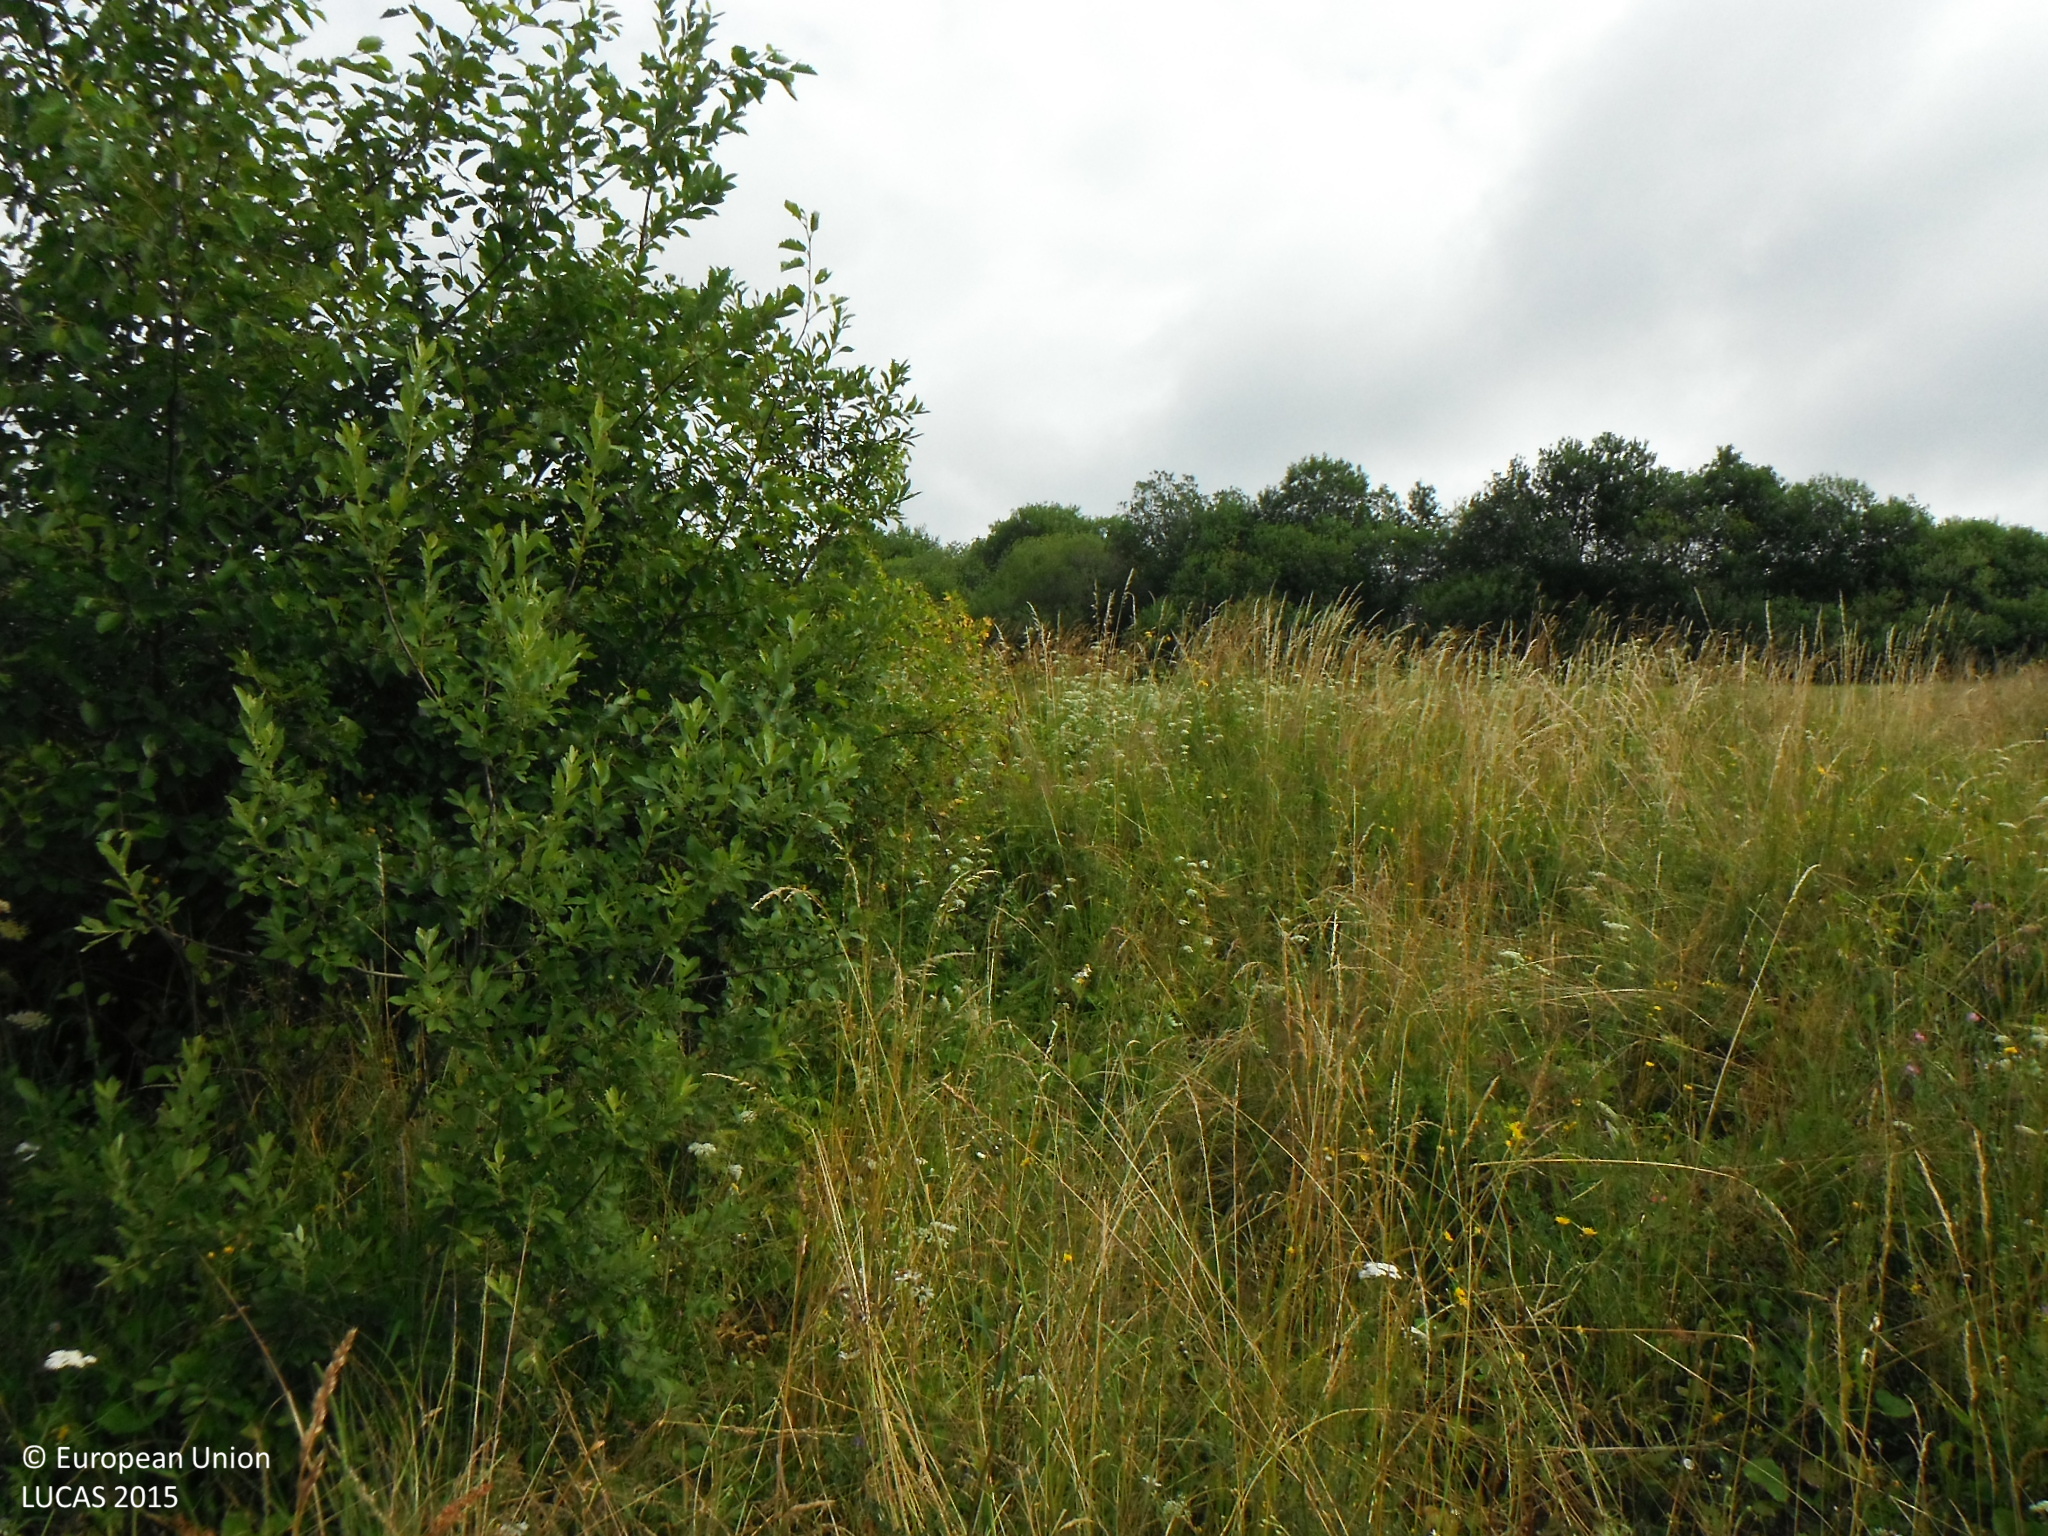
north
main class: Grassland
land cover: Spontaneously vegetated surfaces
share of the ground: > 75 %
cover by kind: herbaceous plants 95 %, shrubs 5 %
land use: Semi-natural and natural areas not in use
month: July
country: SK
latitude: 49.2749
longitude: 22.0004
